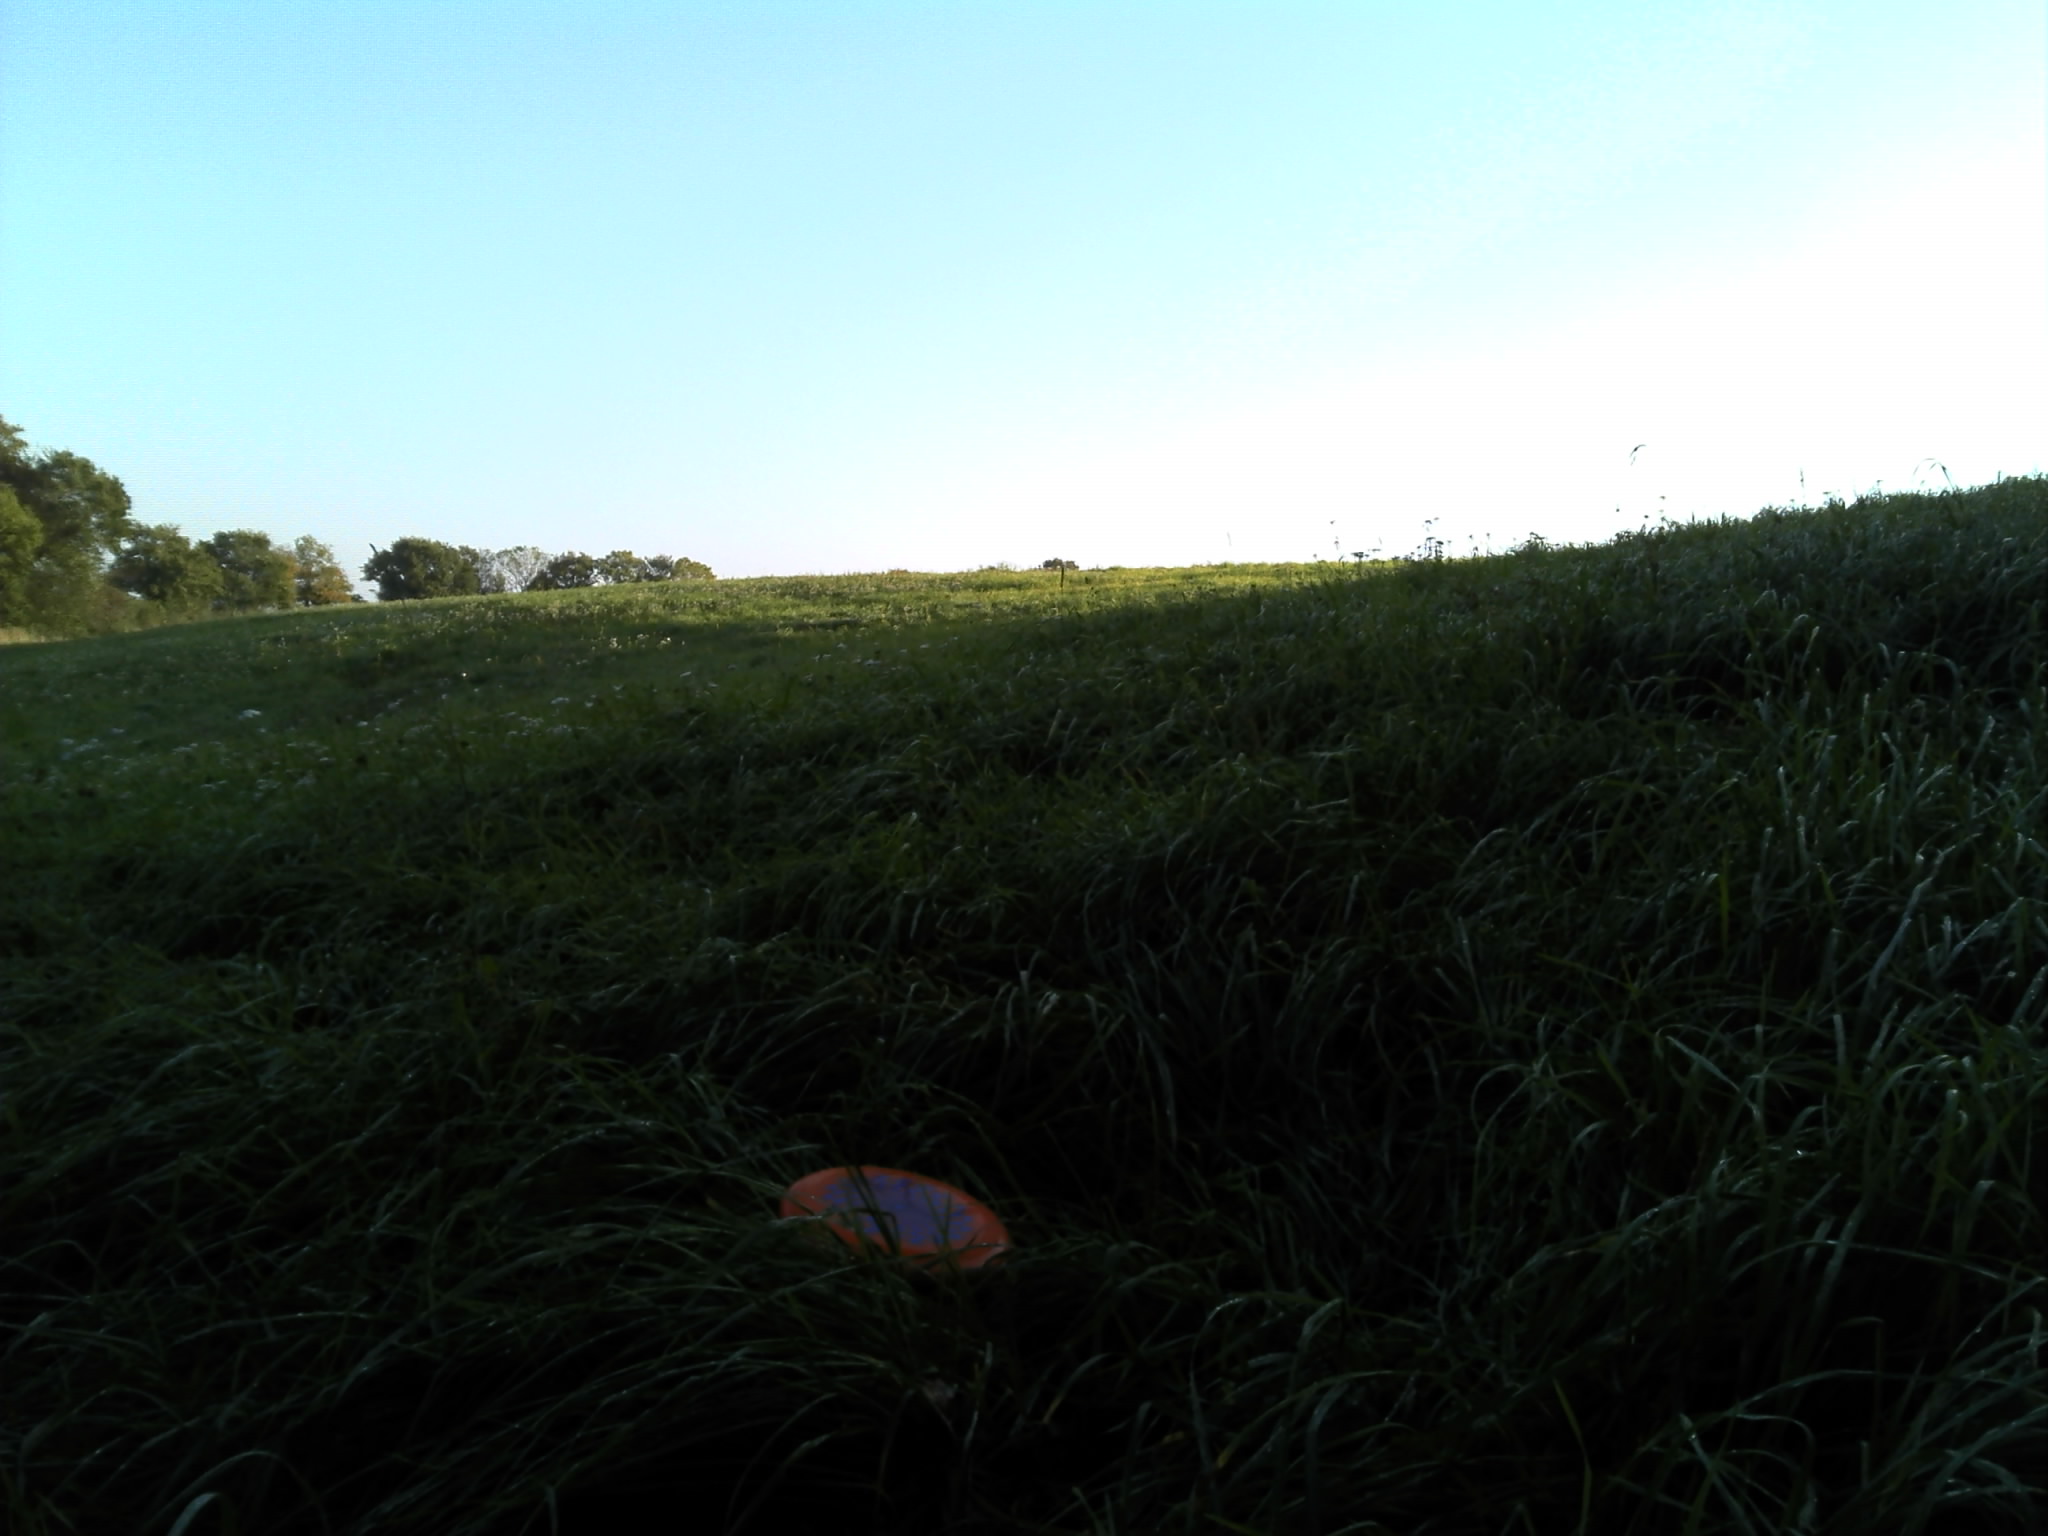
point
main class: Grassland
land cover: Grassland without tree/shrub cover
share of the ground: > 75 %
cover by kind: herbaceous plants 100 %
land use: Agriculture (excluding fallow land and kitchen gardens)
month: October
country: FR
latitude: 47.3462
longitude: -0.9825
